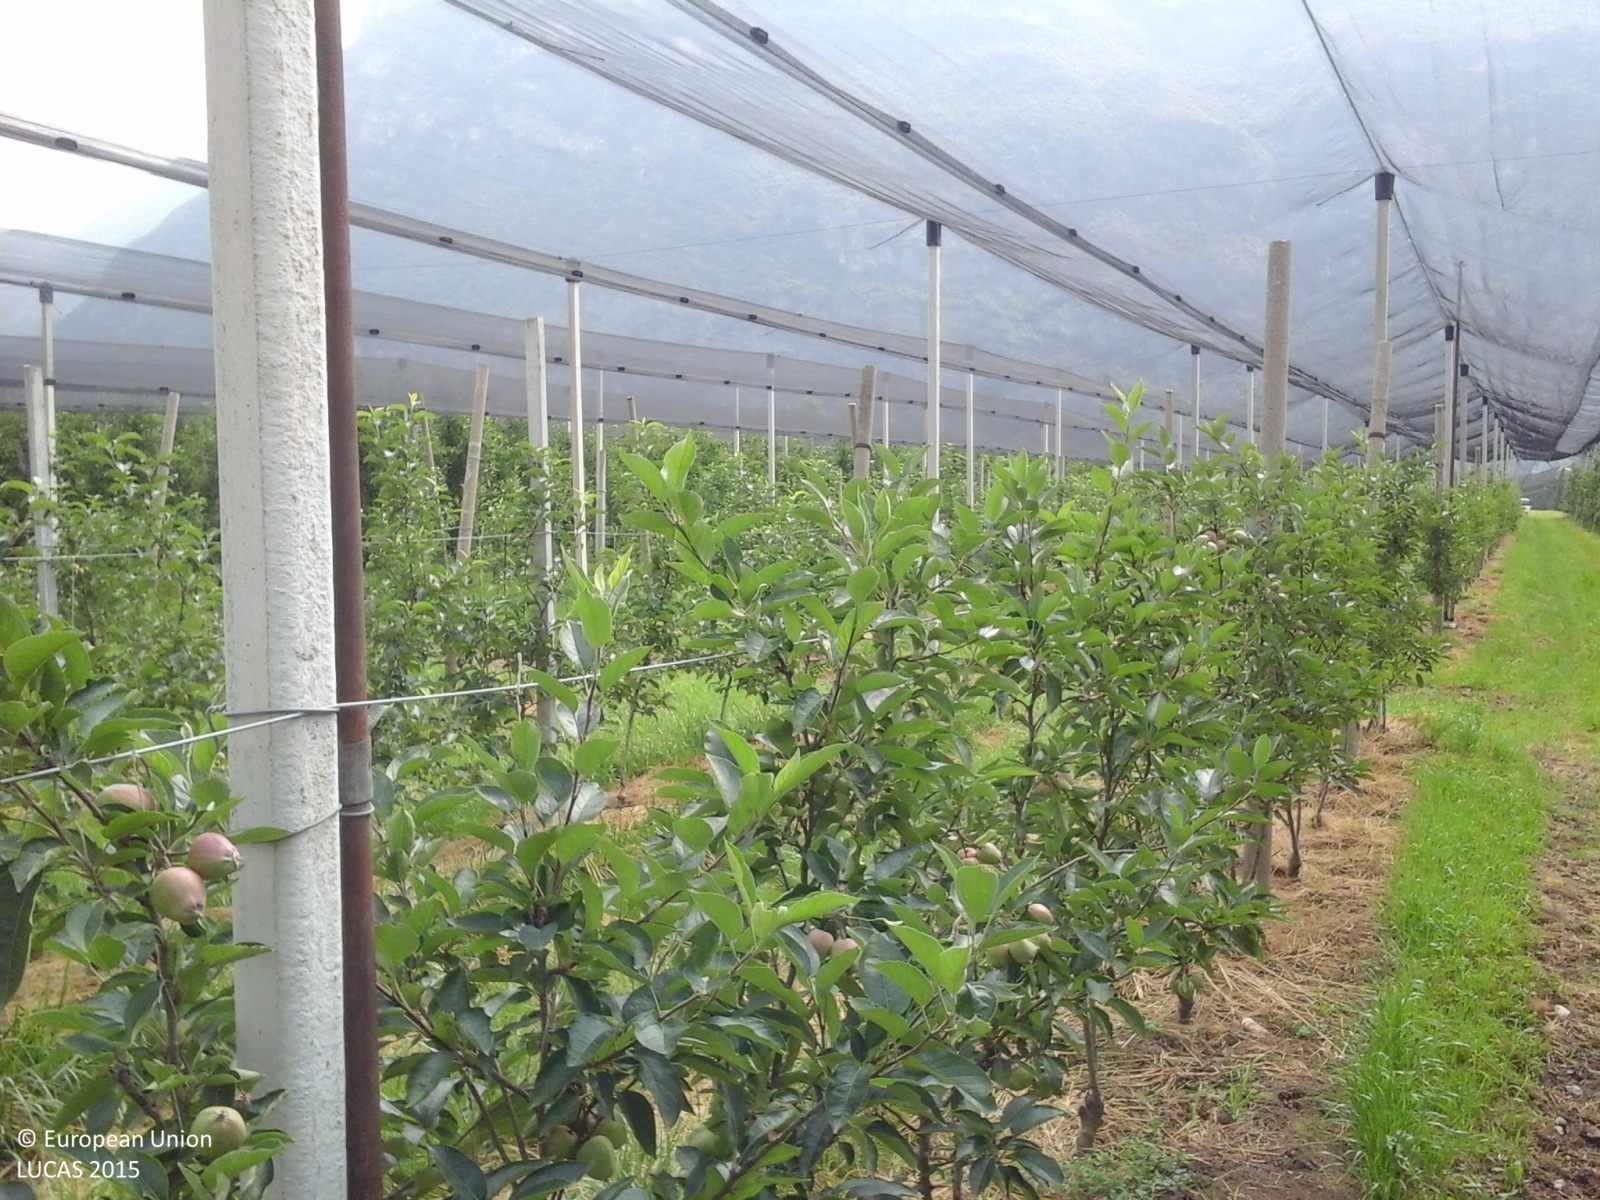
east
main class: Cropland
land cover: Apple fruit
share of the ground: < 10 %
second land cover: Grassland without tree/shrub cover
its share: > 75 %
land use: Agriculture (excluding fallow land and kitchen gardens)
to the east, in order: Apple fruit; Grassland without tree/shrub cover; Grass margins; Ditches and canals; Grass margins; Apple fruit; Tracks; Apple fruit; Grass margins; Apple fruit
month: June
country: IT
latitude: 45.9673
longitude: 11.0953
